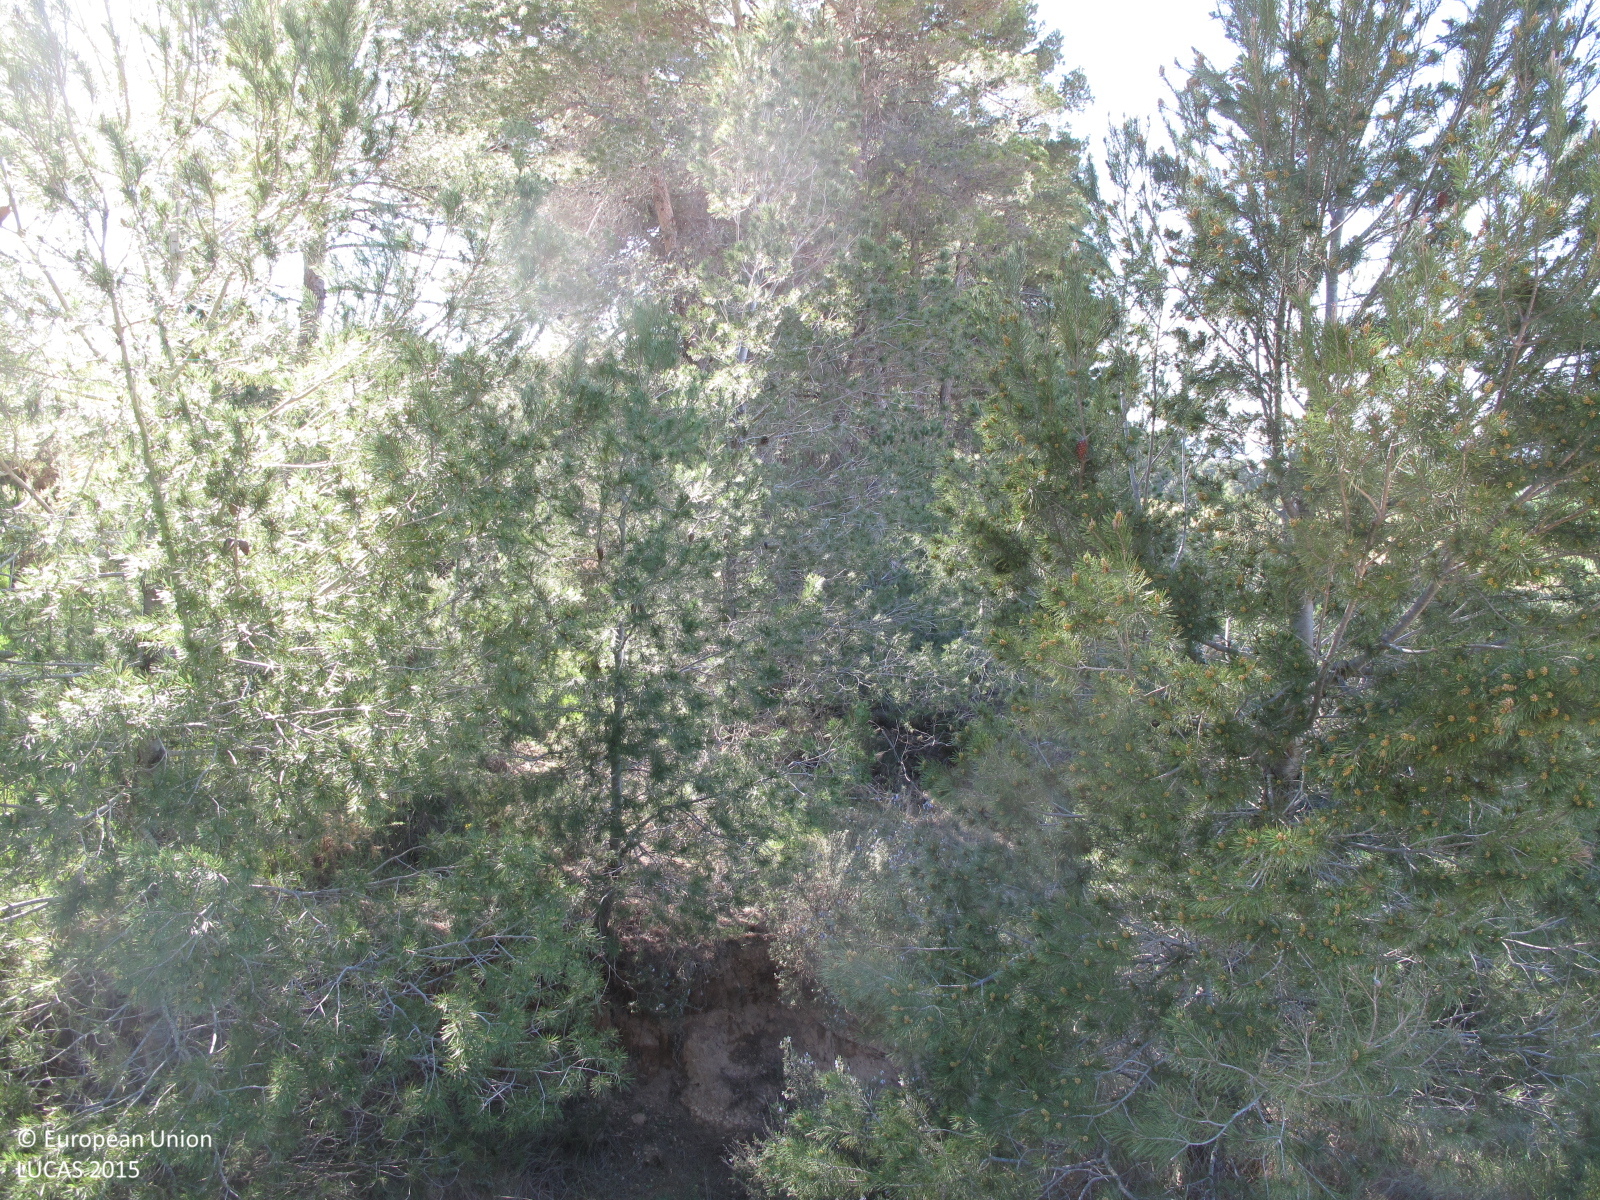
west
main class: Cropland
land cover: Barley
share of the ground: 10 - 25 %
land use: Agriculture (excluding fallow land and kitchen gardens)
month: March
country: ES
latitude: 38.8262
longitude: -0.9933
